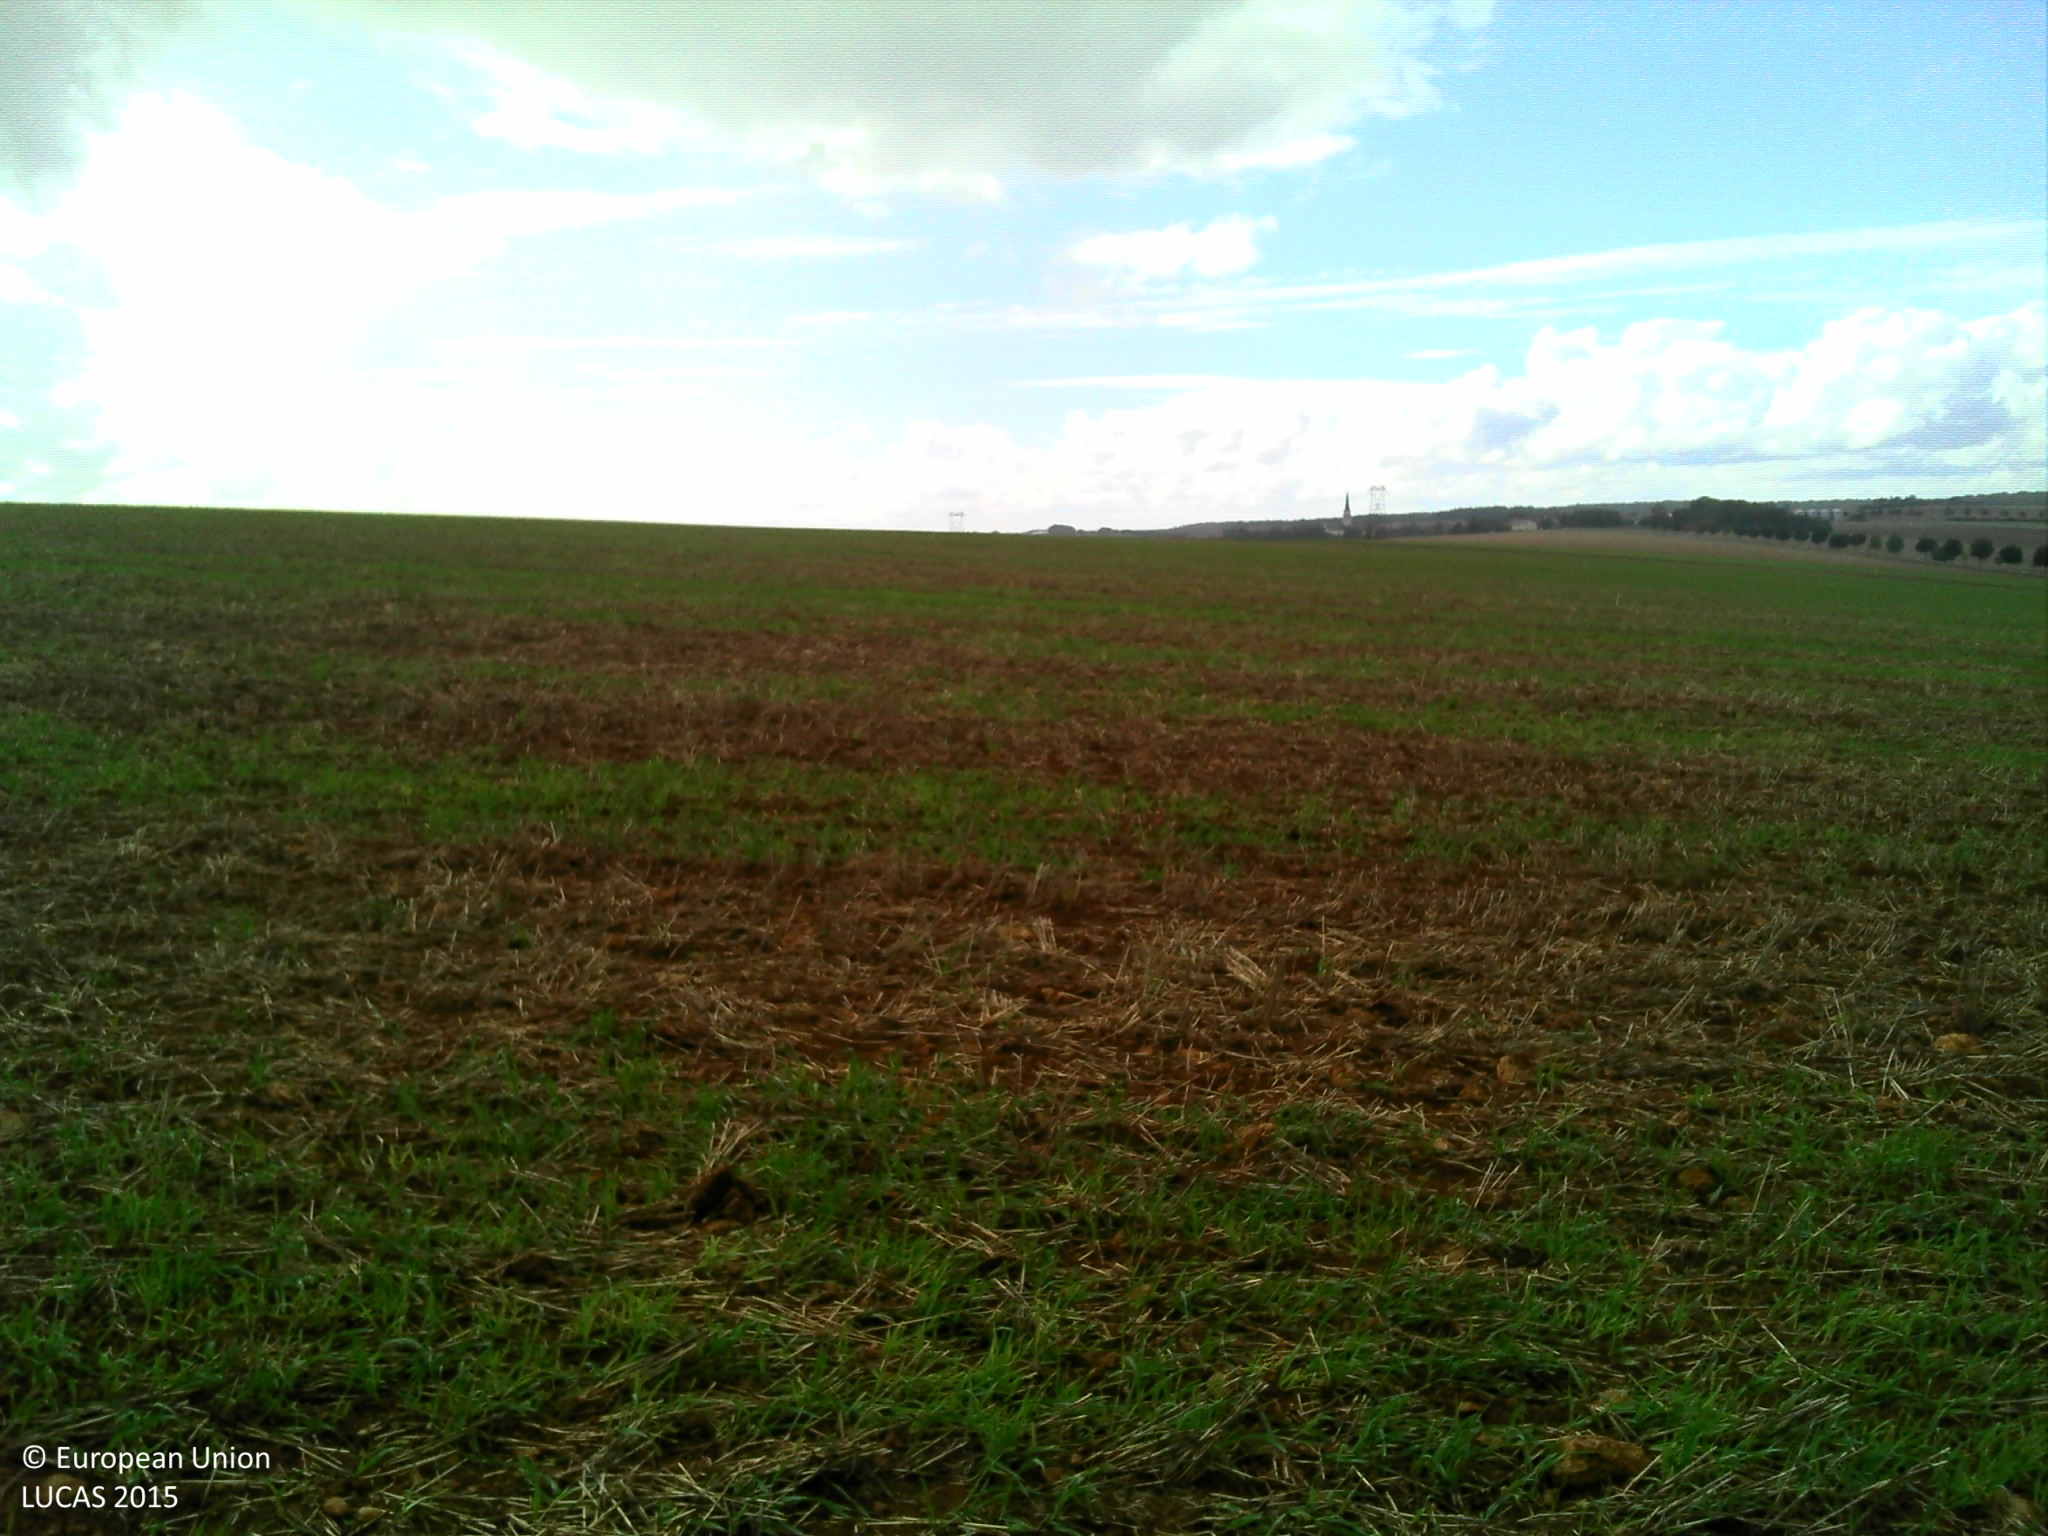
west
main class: Cropland
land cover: Common wheat
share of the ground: < 10 %
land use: Agriculture (excluding fallow land and kitchen gardens)
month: September
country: FR
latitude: 48.8867
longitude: 5.9218
